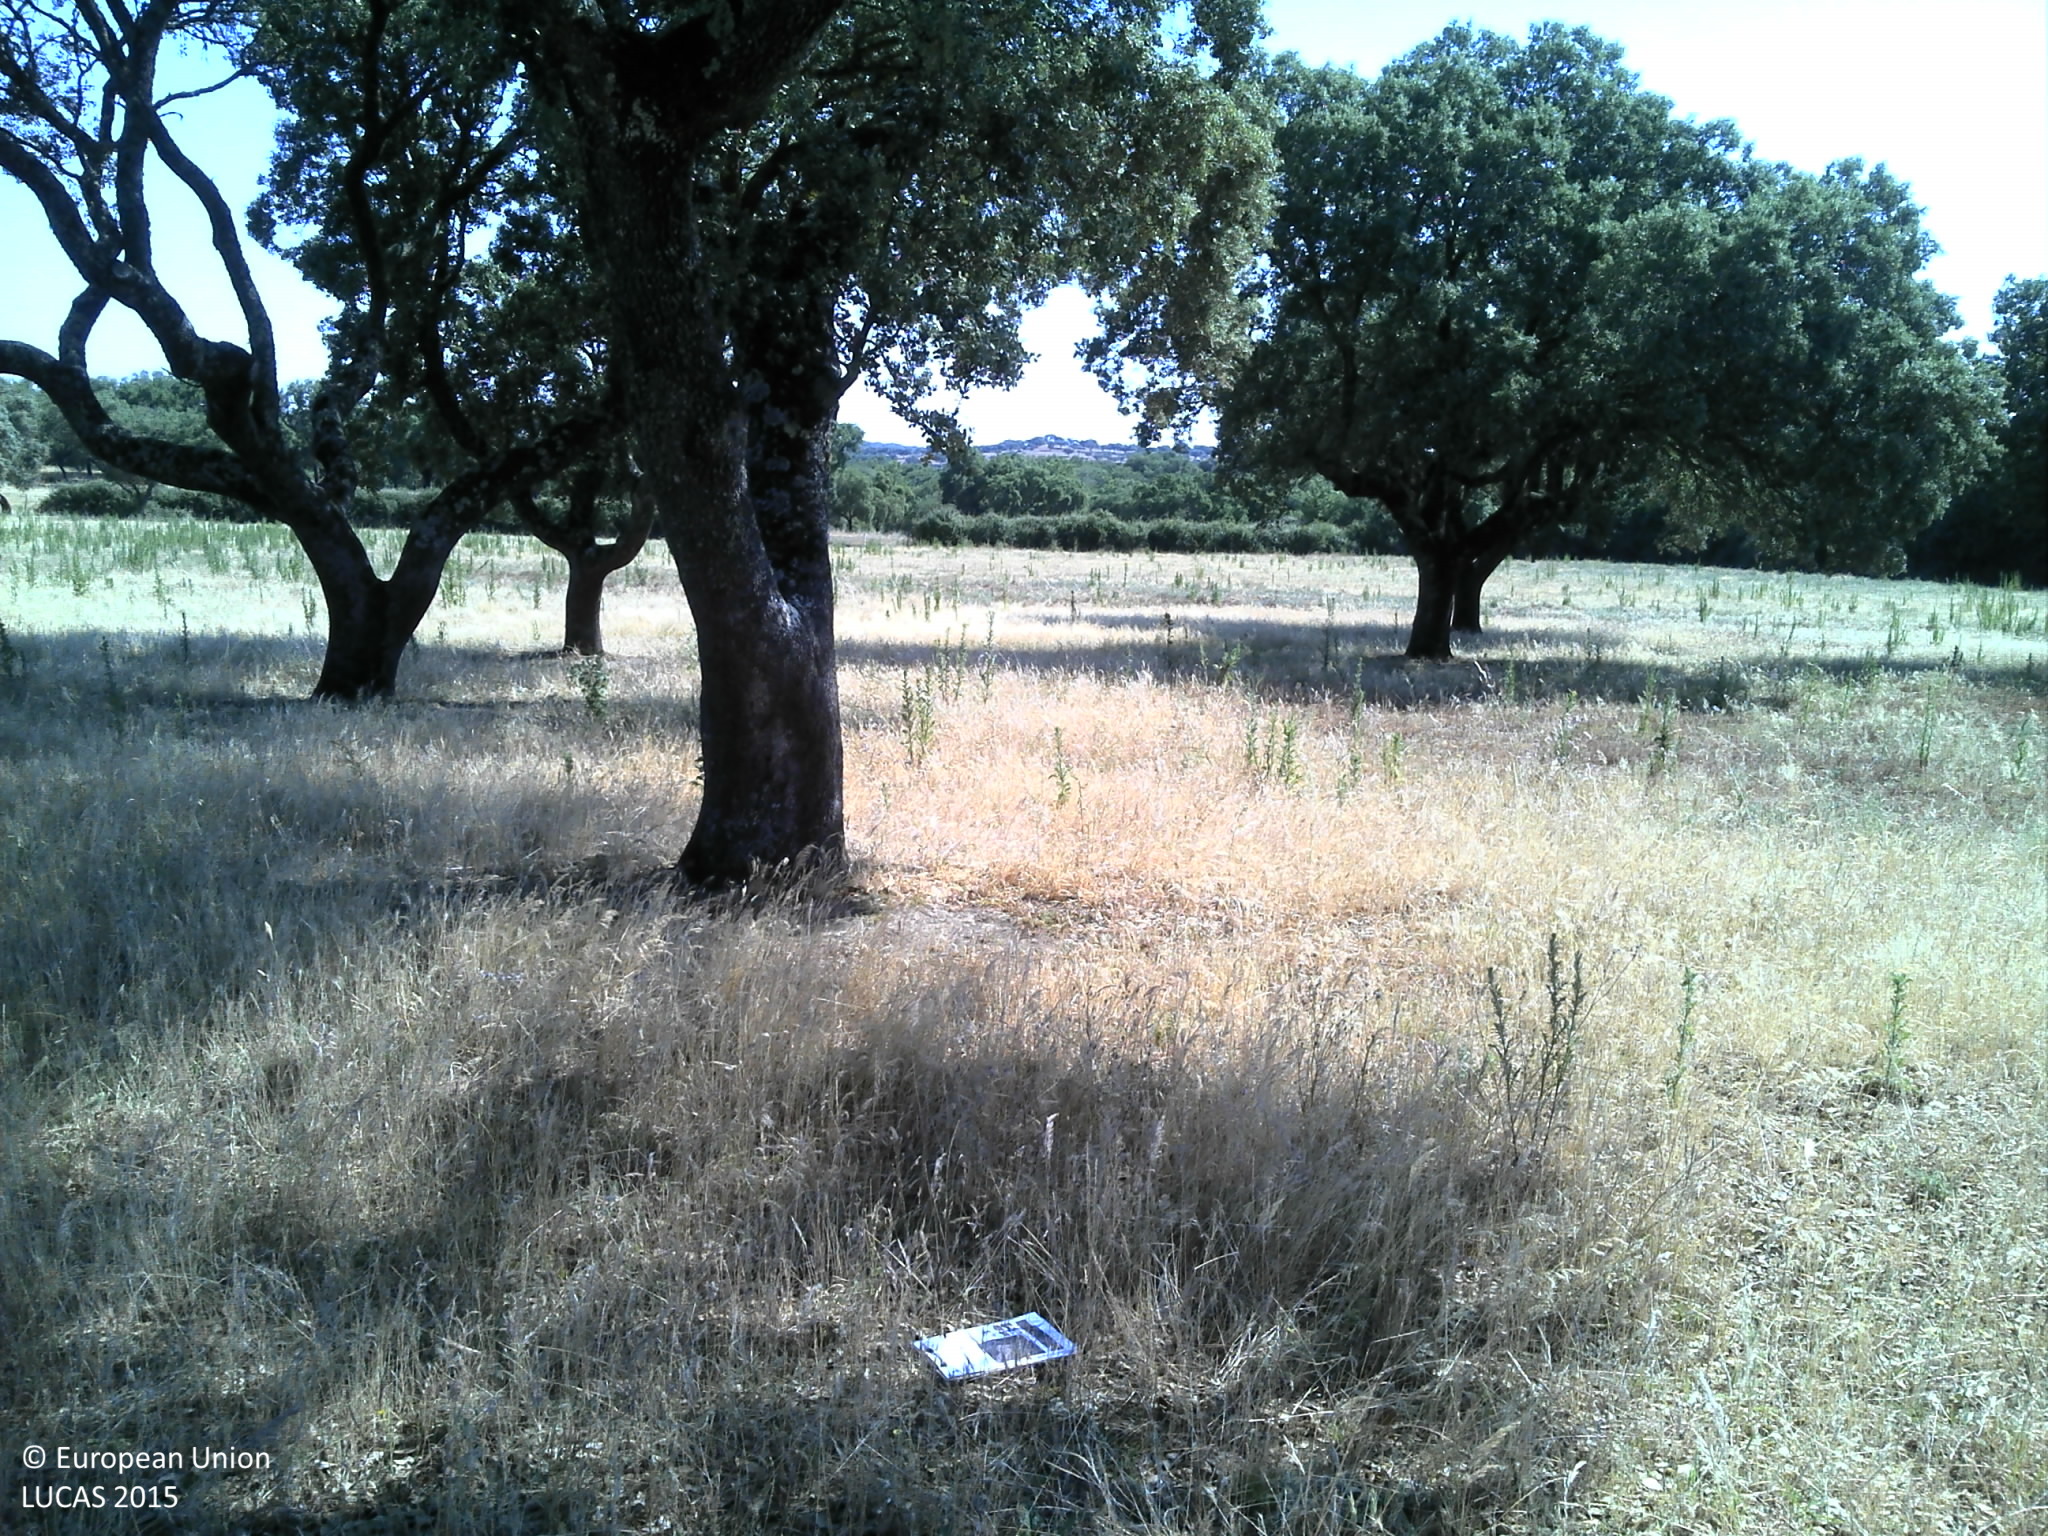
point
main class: Woodland
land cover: Broadleaved woodland
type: broadleaved evergreen forest
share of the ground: 10 - 25 %
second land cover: Spontaneously vegetated surfaces
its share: 25 - 50 %
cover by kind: herbaceous plants 50 %, unconsolidated bare surface 30 %, broadleaved forest trees 20 %
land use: Forestry
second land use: Agriculture (excluding fallow land and kitchen gardens)
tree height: > 5 m
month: June
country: PT
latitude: 38.6120
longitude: -8.0628
